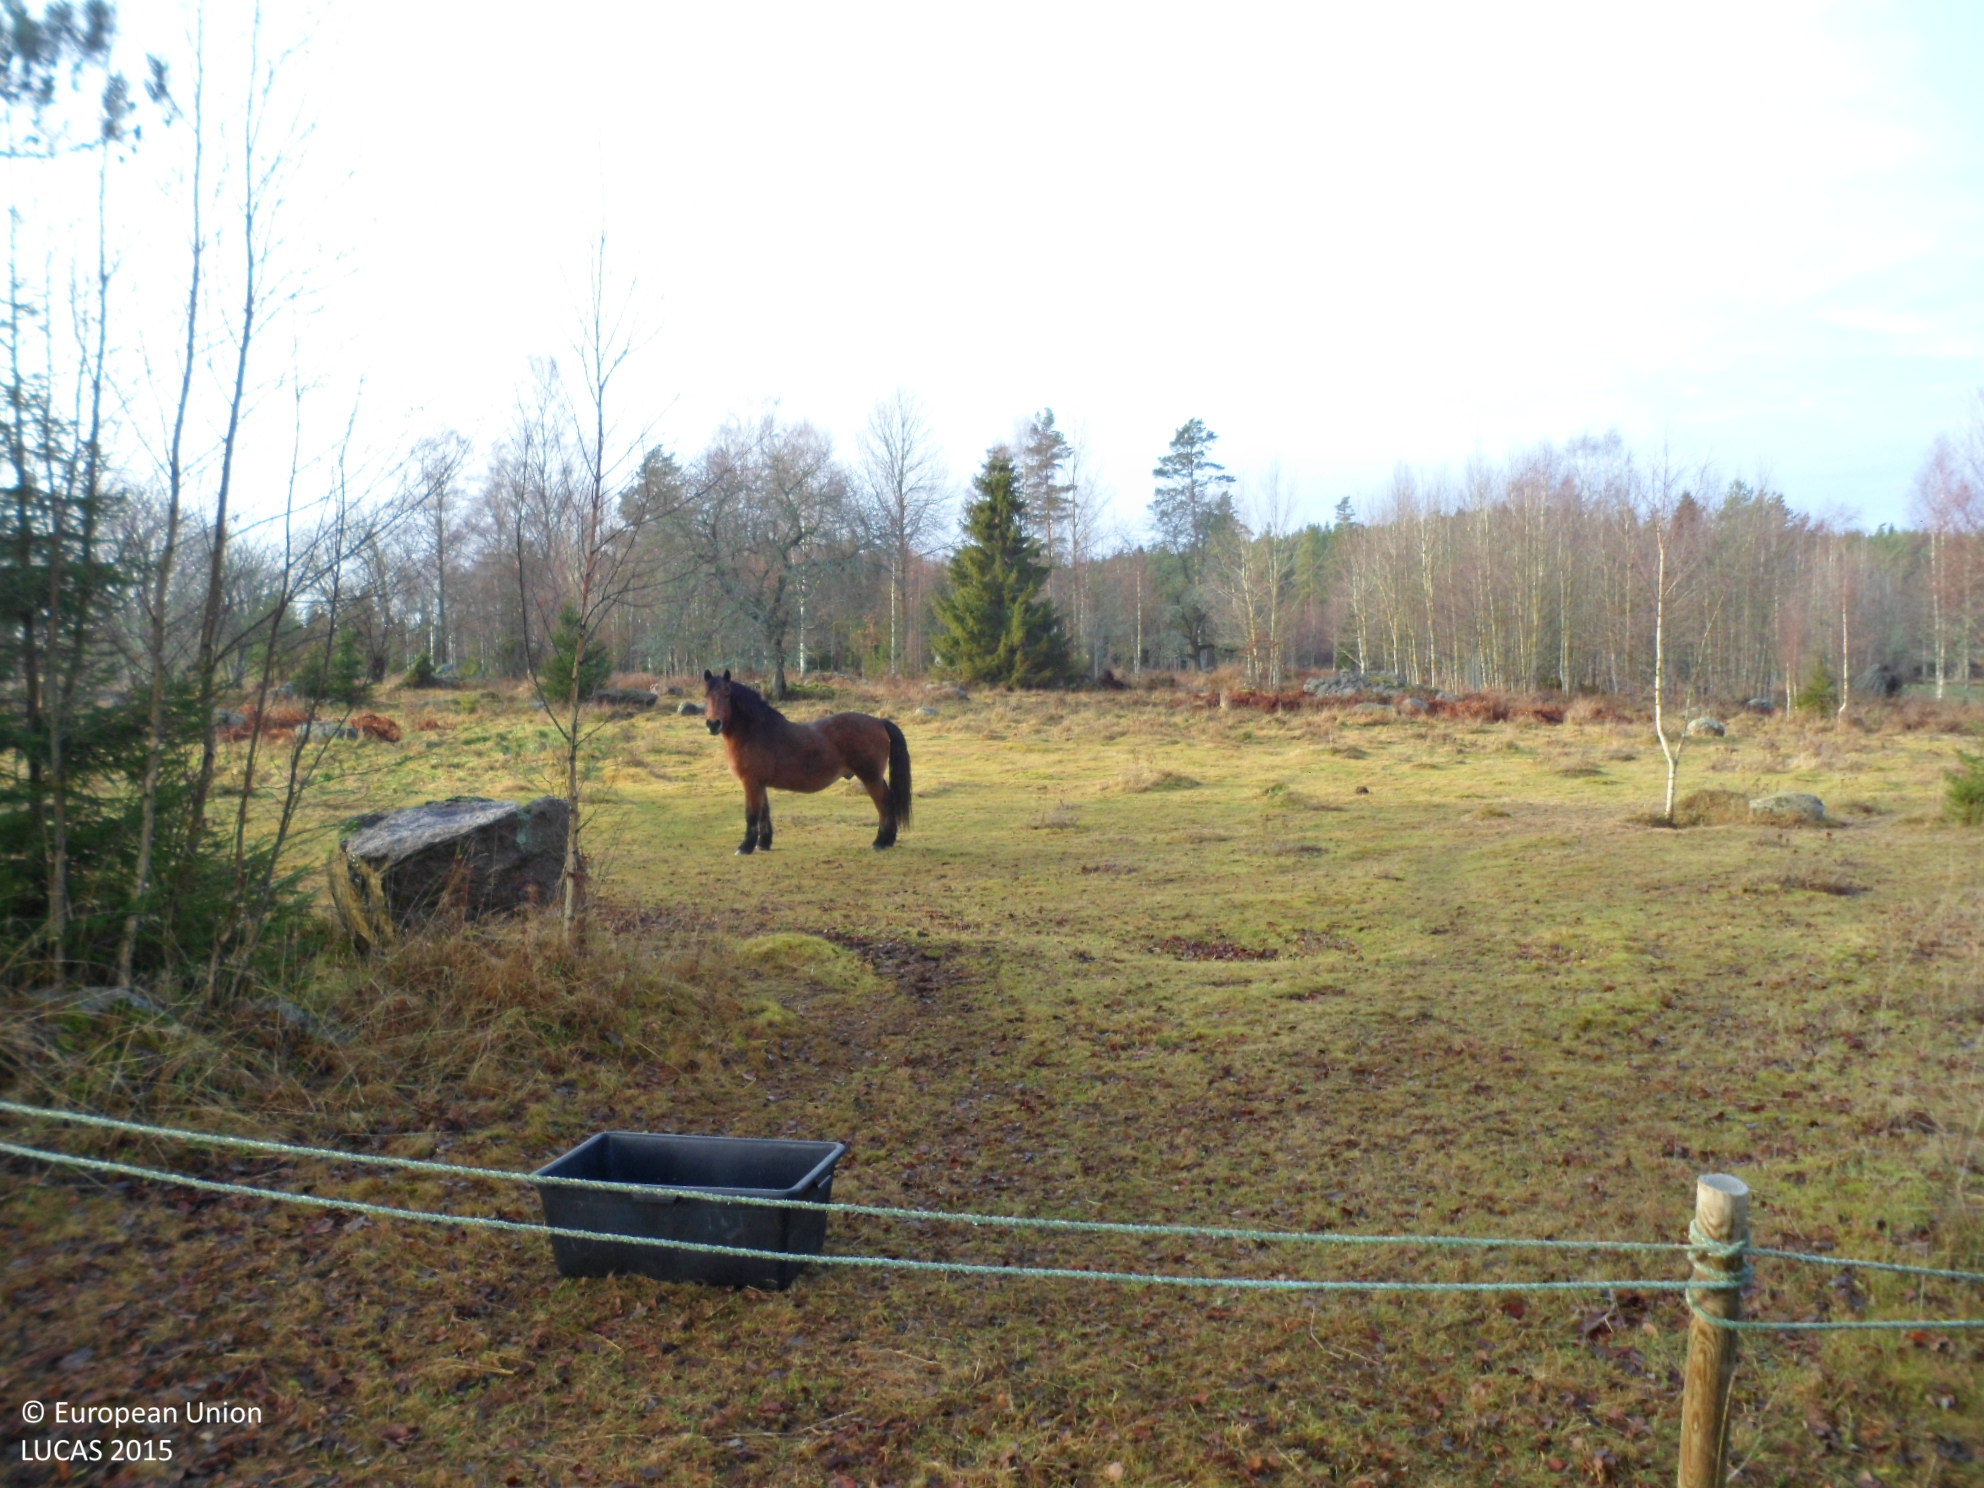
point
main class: Woodland
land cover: Broadleaved woodland
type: hemiboreal forest and nemoral coniferous forest and mixed broadleaved-coniferous forest
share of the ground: 10 - 25 %
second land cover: Grassland without tree/shrub cover
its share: > 75 %
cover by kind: herbaceous plants 55 %, broadleaved forest trees 20 %, shrubs 15 %, coniferous forest trees 5 %, lichens and mosses 5 %
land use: Forestry
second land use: Agriculture (excluding fallow land and kitchen gardens)
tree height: > 5 m
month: November
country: SE
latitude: 57.7468
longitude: 15.4900
